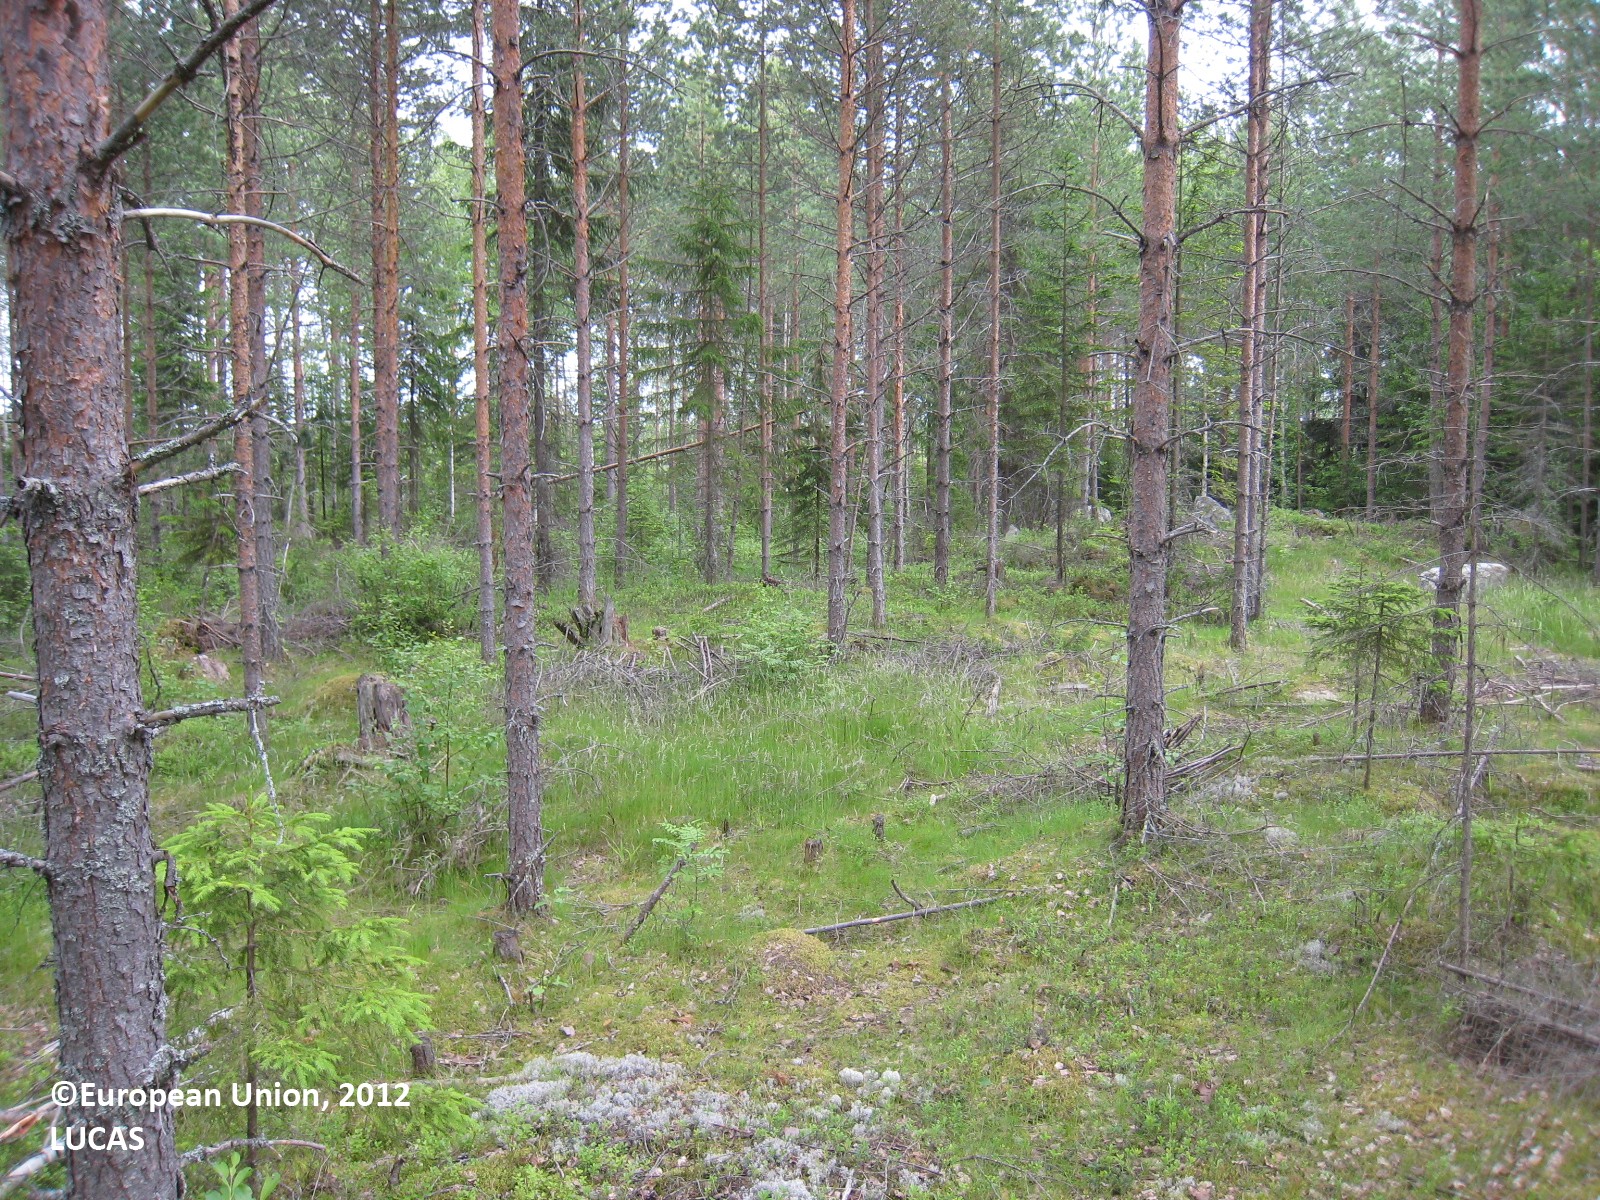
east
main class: Woodland
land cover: Pine dominated coniferous woodland
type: boreal forest
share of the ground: 50 - 75 %
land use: Forestry
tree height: > 5 m
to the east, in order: Pine dominated coniferous woodland; Other mixed woodland; Pine dominated mixed woodland; Ditches and canals; Spruce dominated mixed woodland; Tracks; Other mixed woodland; Ditches and canals; Other mixed woodland; Other coniferous woodland; Spruce dominated mixed woodland
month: June
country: FI
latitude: 62.1700
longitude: 26.3618
